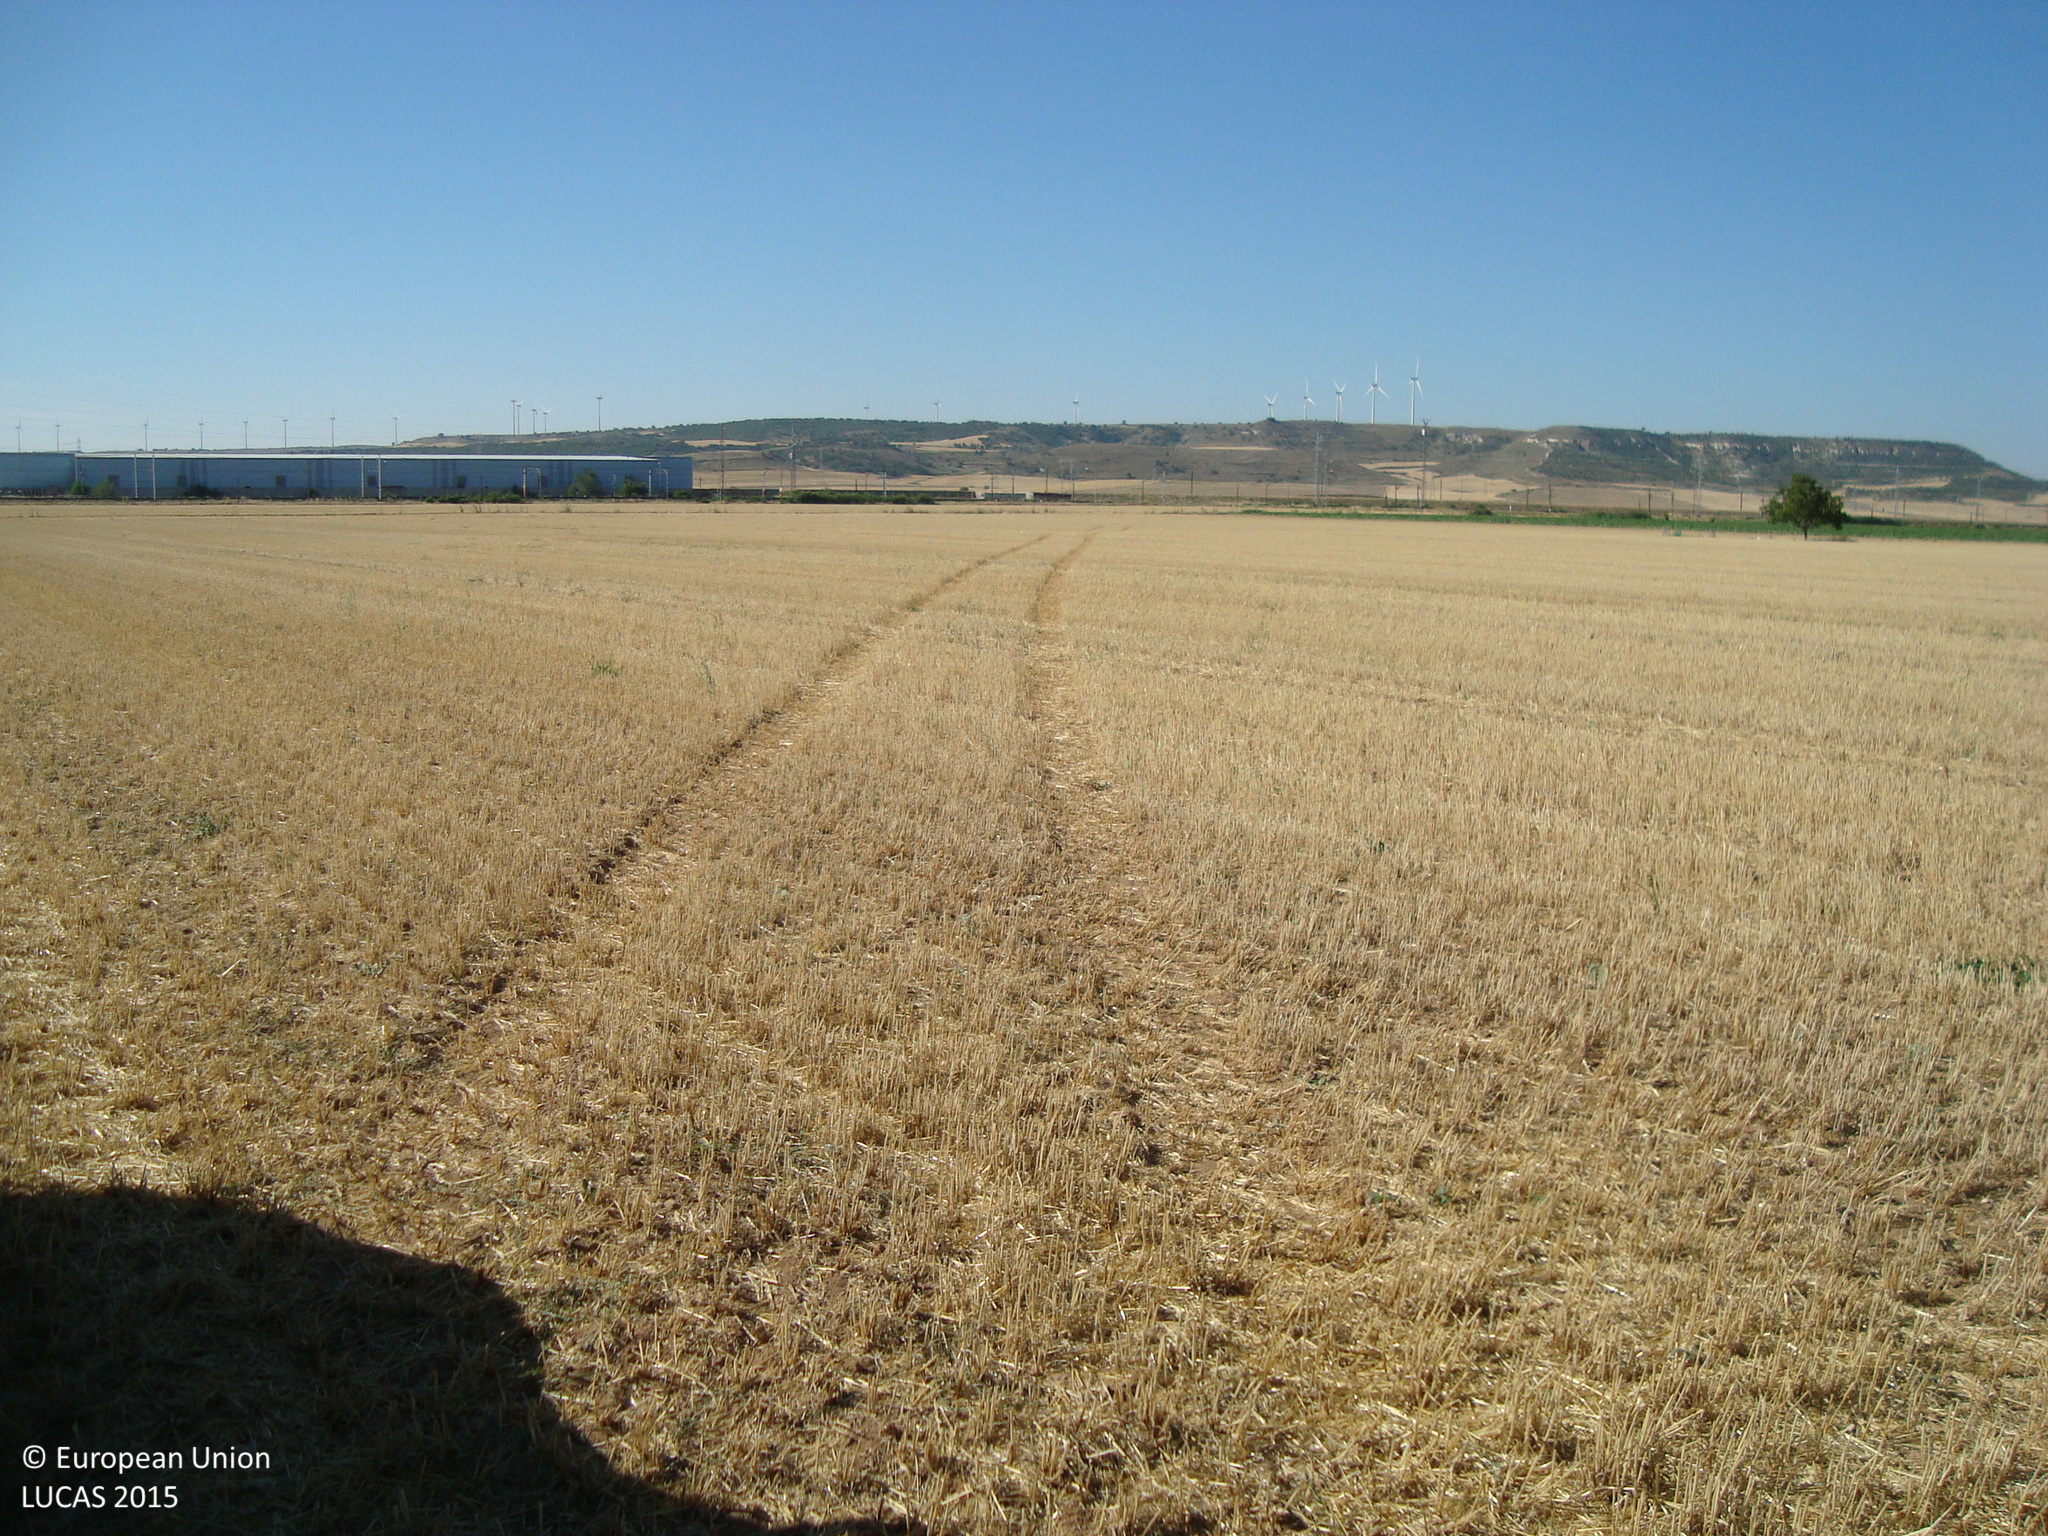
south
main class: Cropland
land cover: Barley
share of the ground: < 10 %
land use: Agriculture (excluding fallow land and kitchen gardens)
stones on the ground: < 10 %
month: July
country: ES
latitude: 42.0174
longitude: -4.3041
